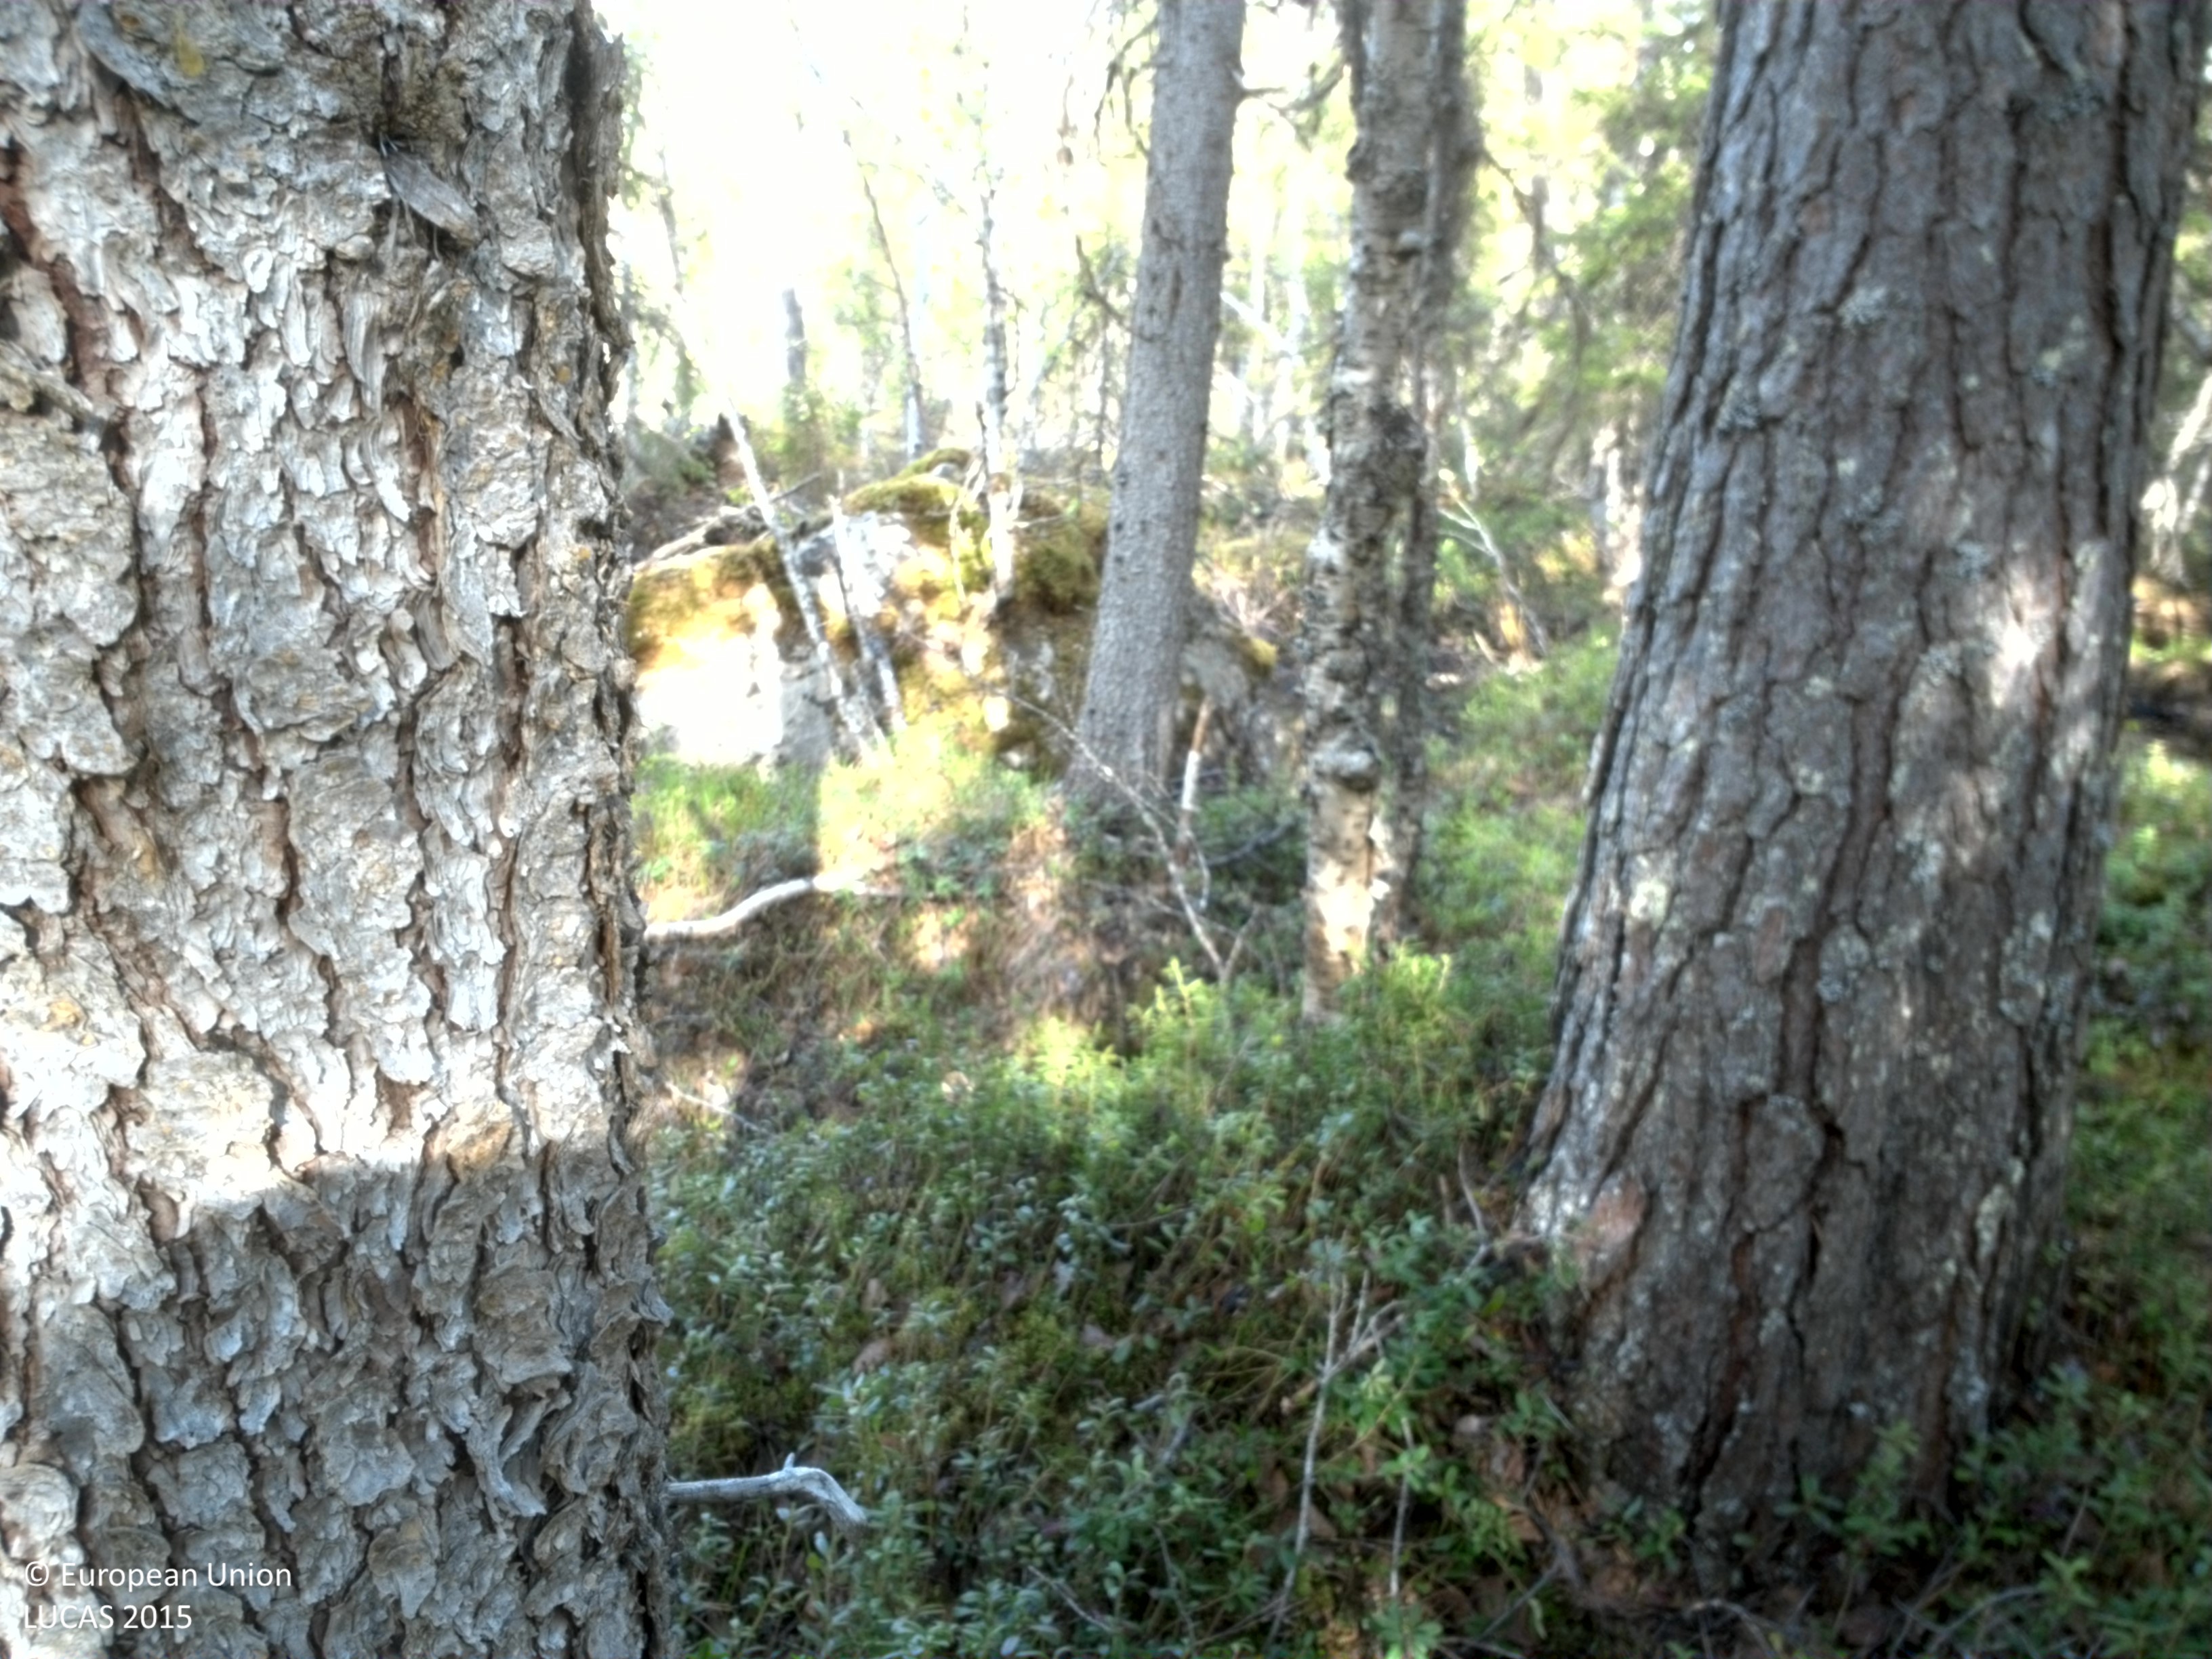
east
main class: Woodland
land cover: Spruce dominated mixed woodland
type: boreal forest
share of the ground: 25 - 50 %
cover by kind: herbaceous plants 45 %, coniferous forest trees 30 %, broadleaved forest trees 10 %, lichens and mosses 5 %
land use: Forestry
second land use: Amenities, museums, leisure
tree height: > 5 m
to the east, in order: Spruce dominated mixed woodland; Pine dominated mixed woodland; Rocks and stones; Spruce dominated coniferous woodland; Lichens and moss; Pine dominated mixed woodland; Broadleaved woodland; Shrubland with sparse tree cover; Pine dominated mixed woodland; Spruce dominated mixed woodland; Other mixed woodland; Spruce dominated mixed woodland; Spruce dominated coniferous woodland; Spruce dominated mixed woodland; Ditches and canals; Broadleaved woodland; Artificial constructions in urban areas; Shrubland with sparse tree cover; Broadleaved woodland
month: June
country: SE
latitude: 66.7012
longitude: 21.8578
